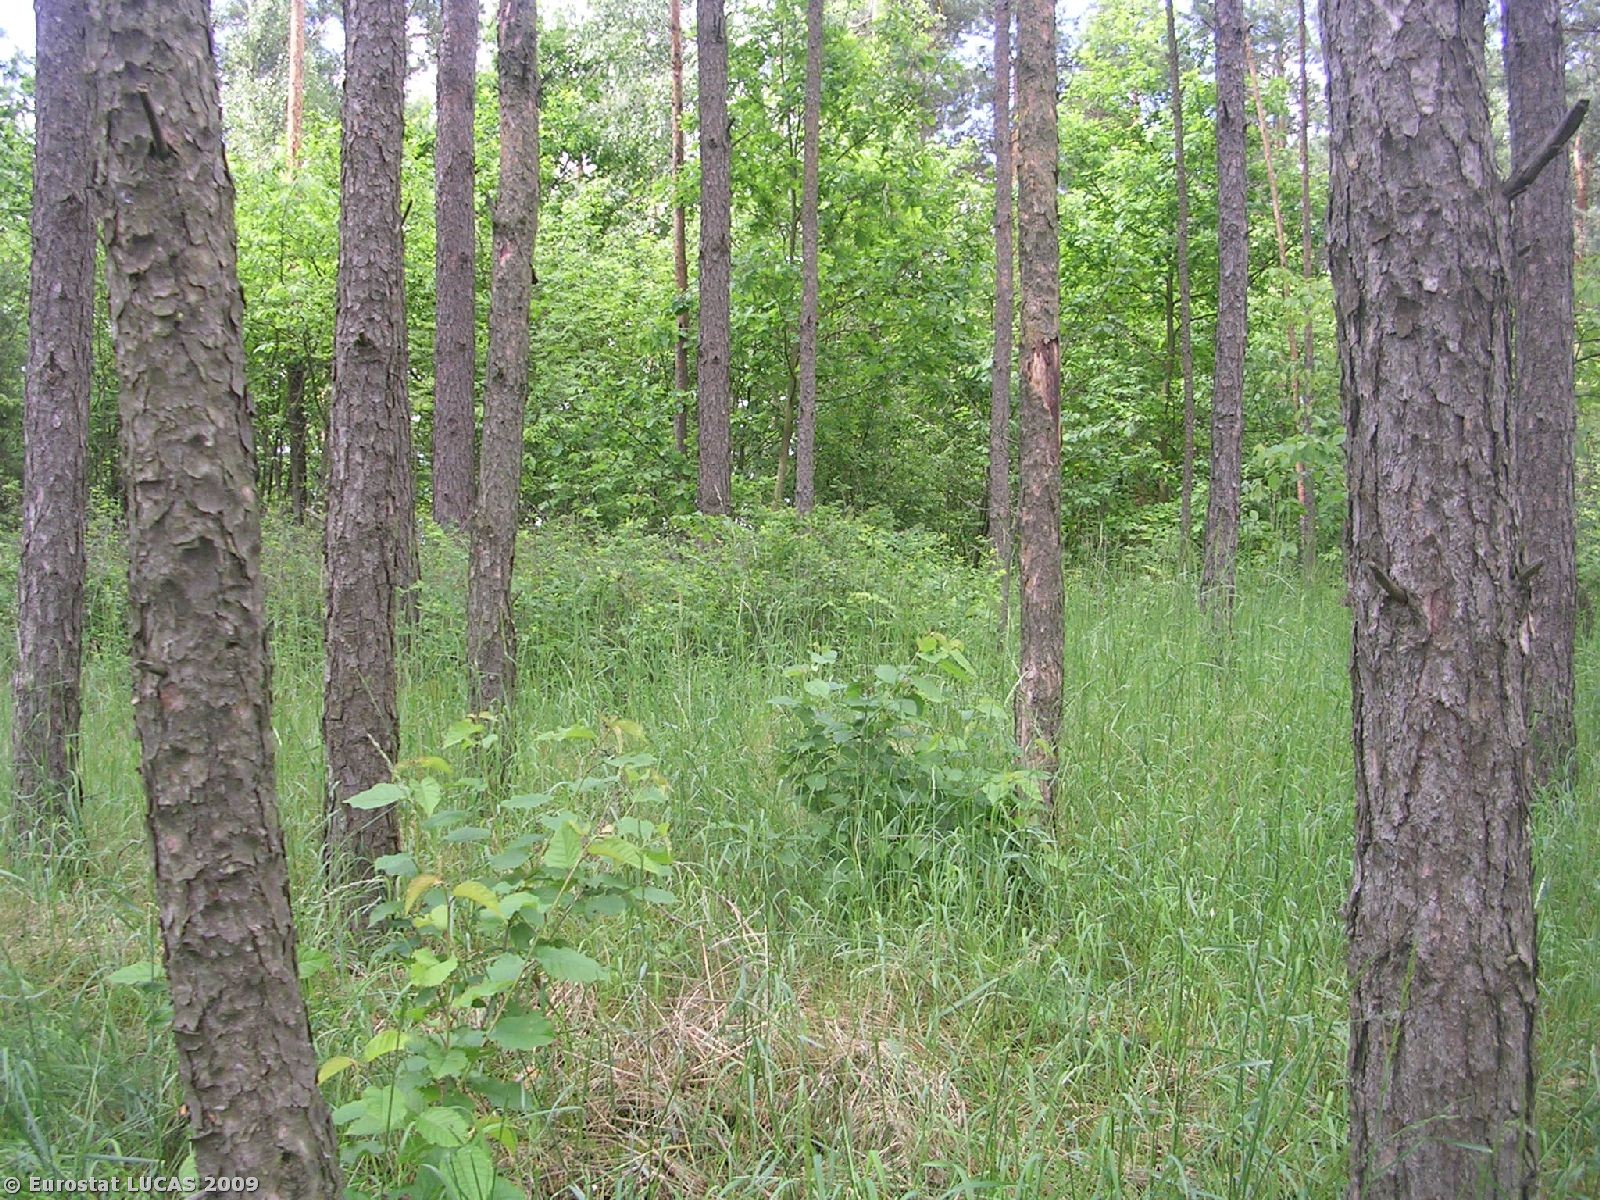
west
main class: Woodland
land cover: Coniferous woodland
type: hemiboreal forest and nemoral coniferous forest and mixed broadleaved-coniferous forest
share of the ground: 25 - 50 %
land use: Forestry
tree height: > 5 m
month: April
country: PL
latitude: 53.5390
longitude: 23.4671
